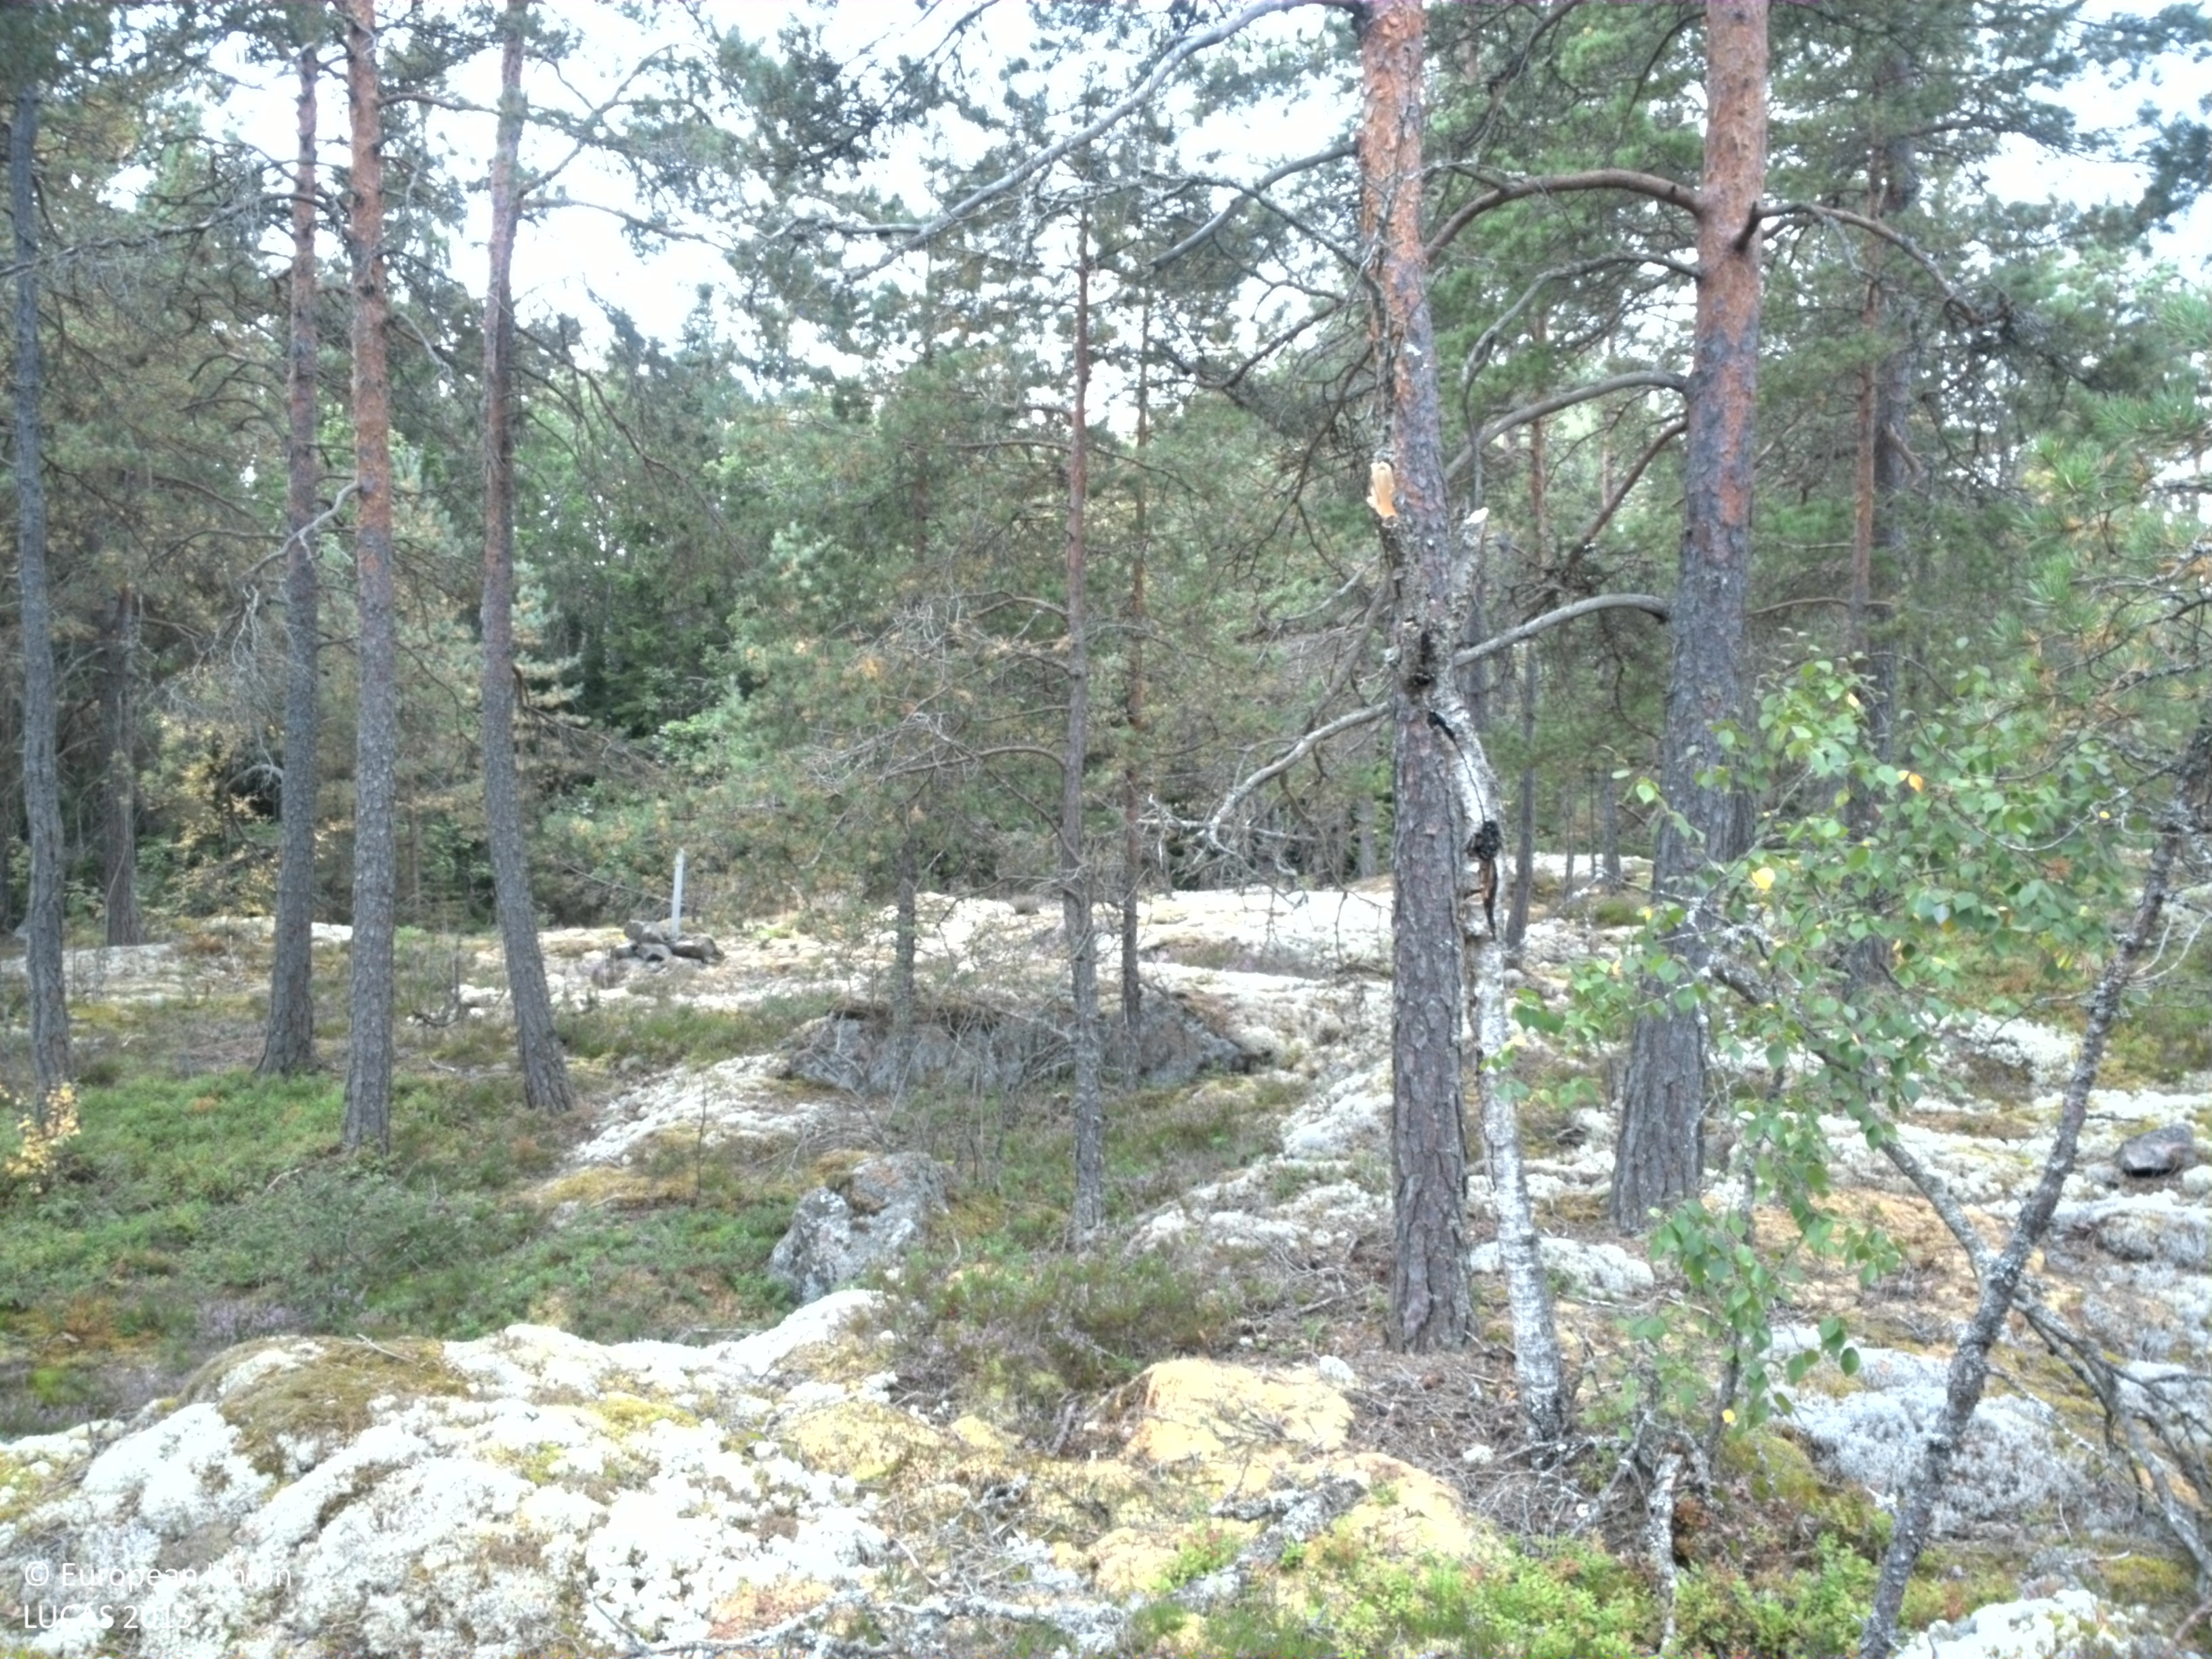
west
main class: Woodland
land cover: Pine dominated coniferous woodland
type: boreal forest
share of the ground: 50 - 75 %
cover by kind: coniferous forest trees 50 %, lichens and mosses 25 %, shrubs 10 %, consolidated bare surface 10 %, herbaceous plants 5 %
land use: Forestry
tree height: > 5 m
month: August
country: SE
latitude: 59.9157
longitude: 17.7027
